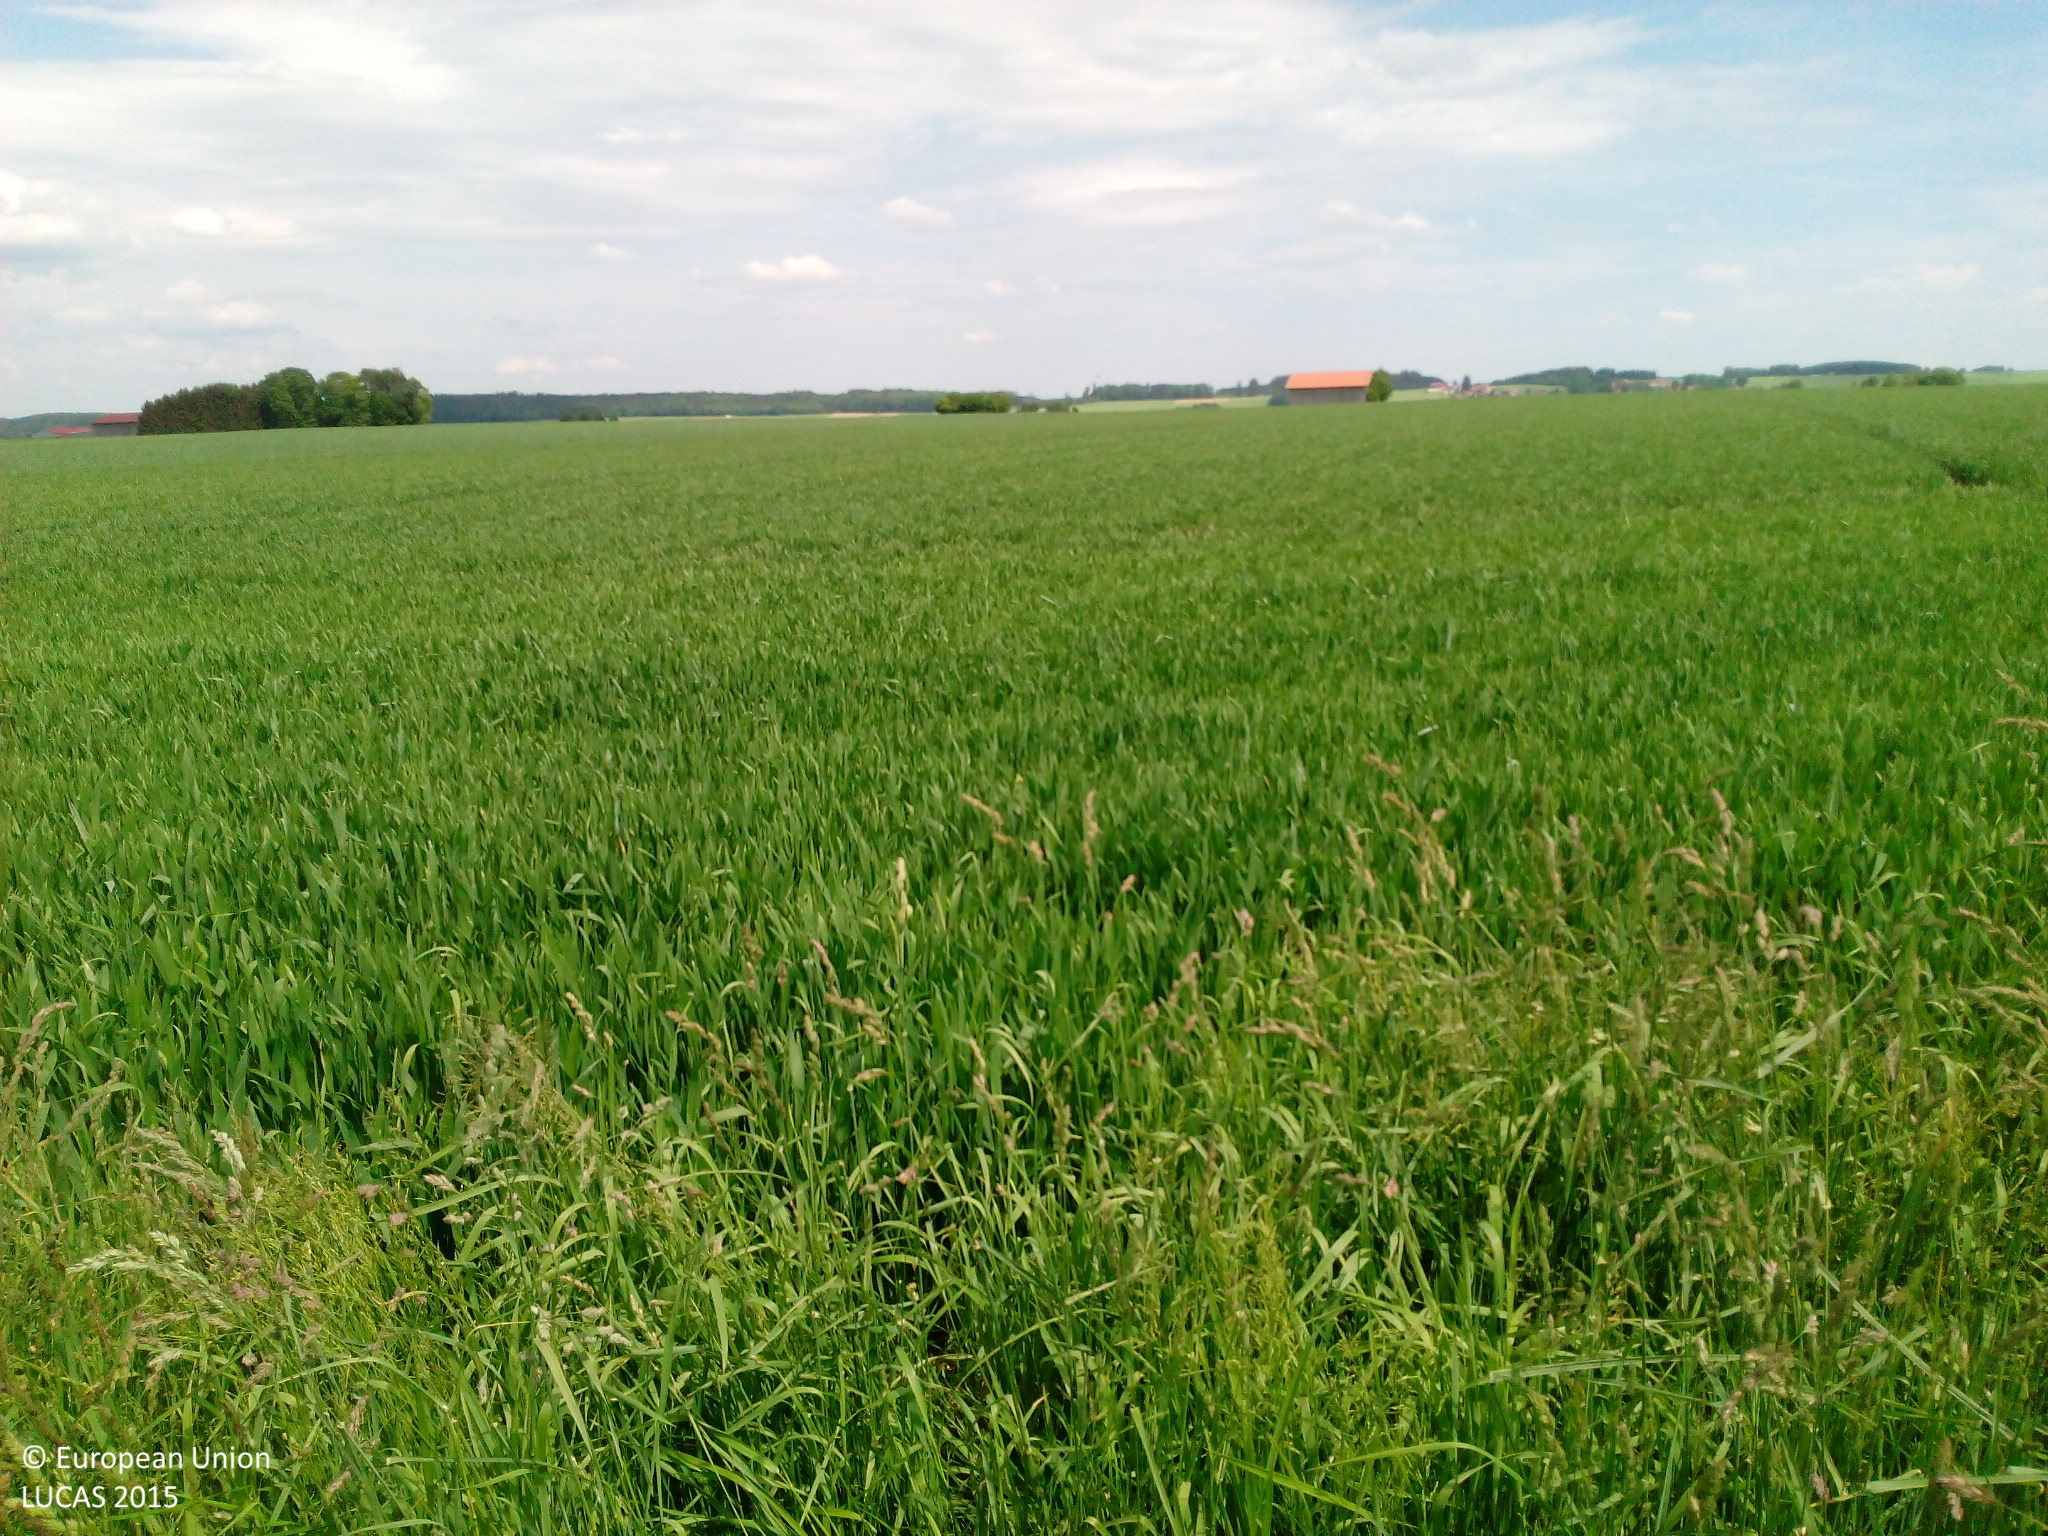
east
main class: Cropland
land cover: Rye
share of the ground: > 75 %
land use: Agriculture (excluding fallow land and kitchen gardens)
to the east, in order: Rye
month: May
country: DE
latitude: 48.1692
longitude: 10.2553
